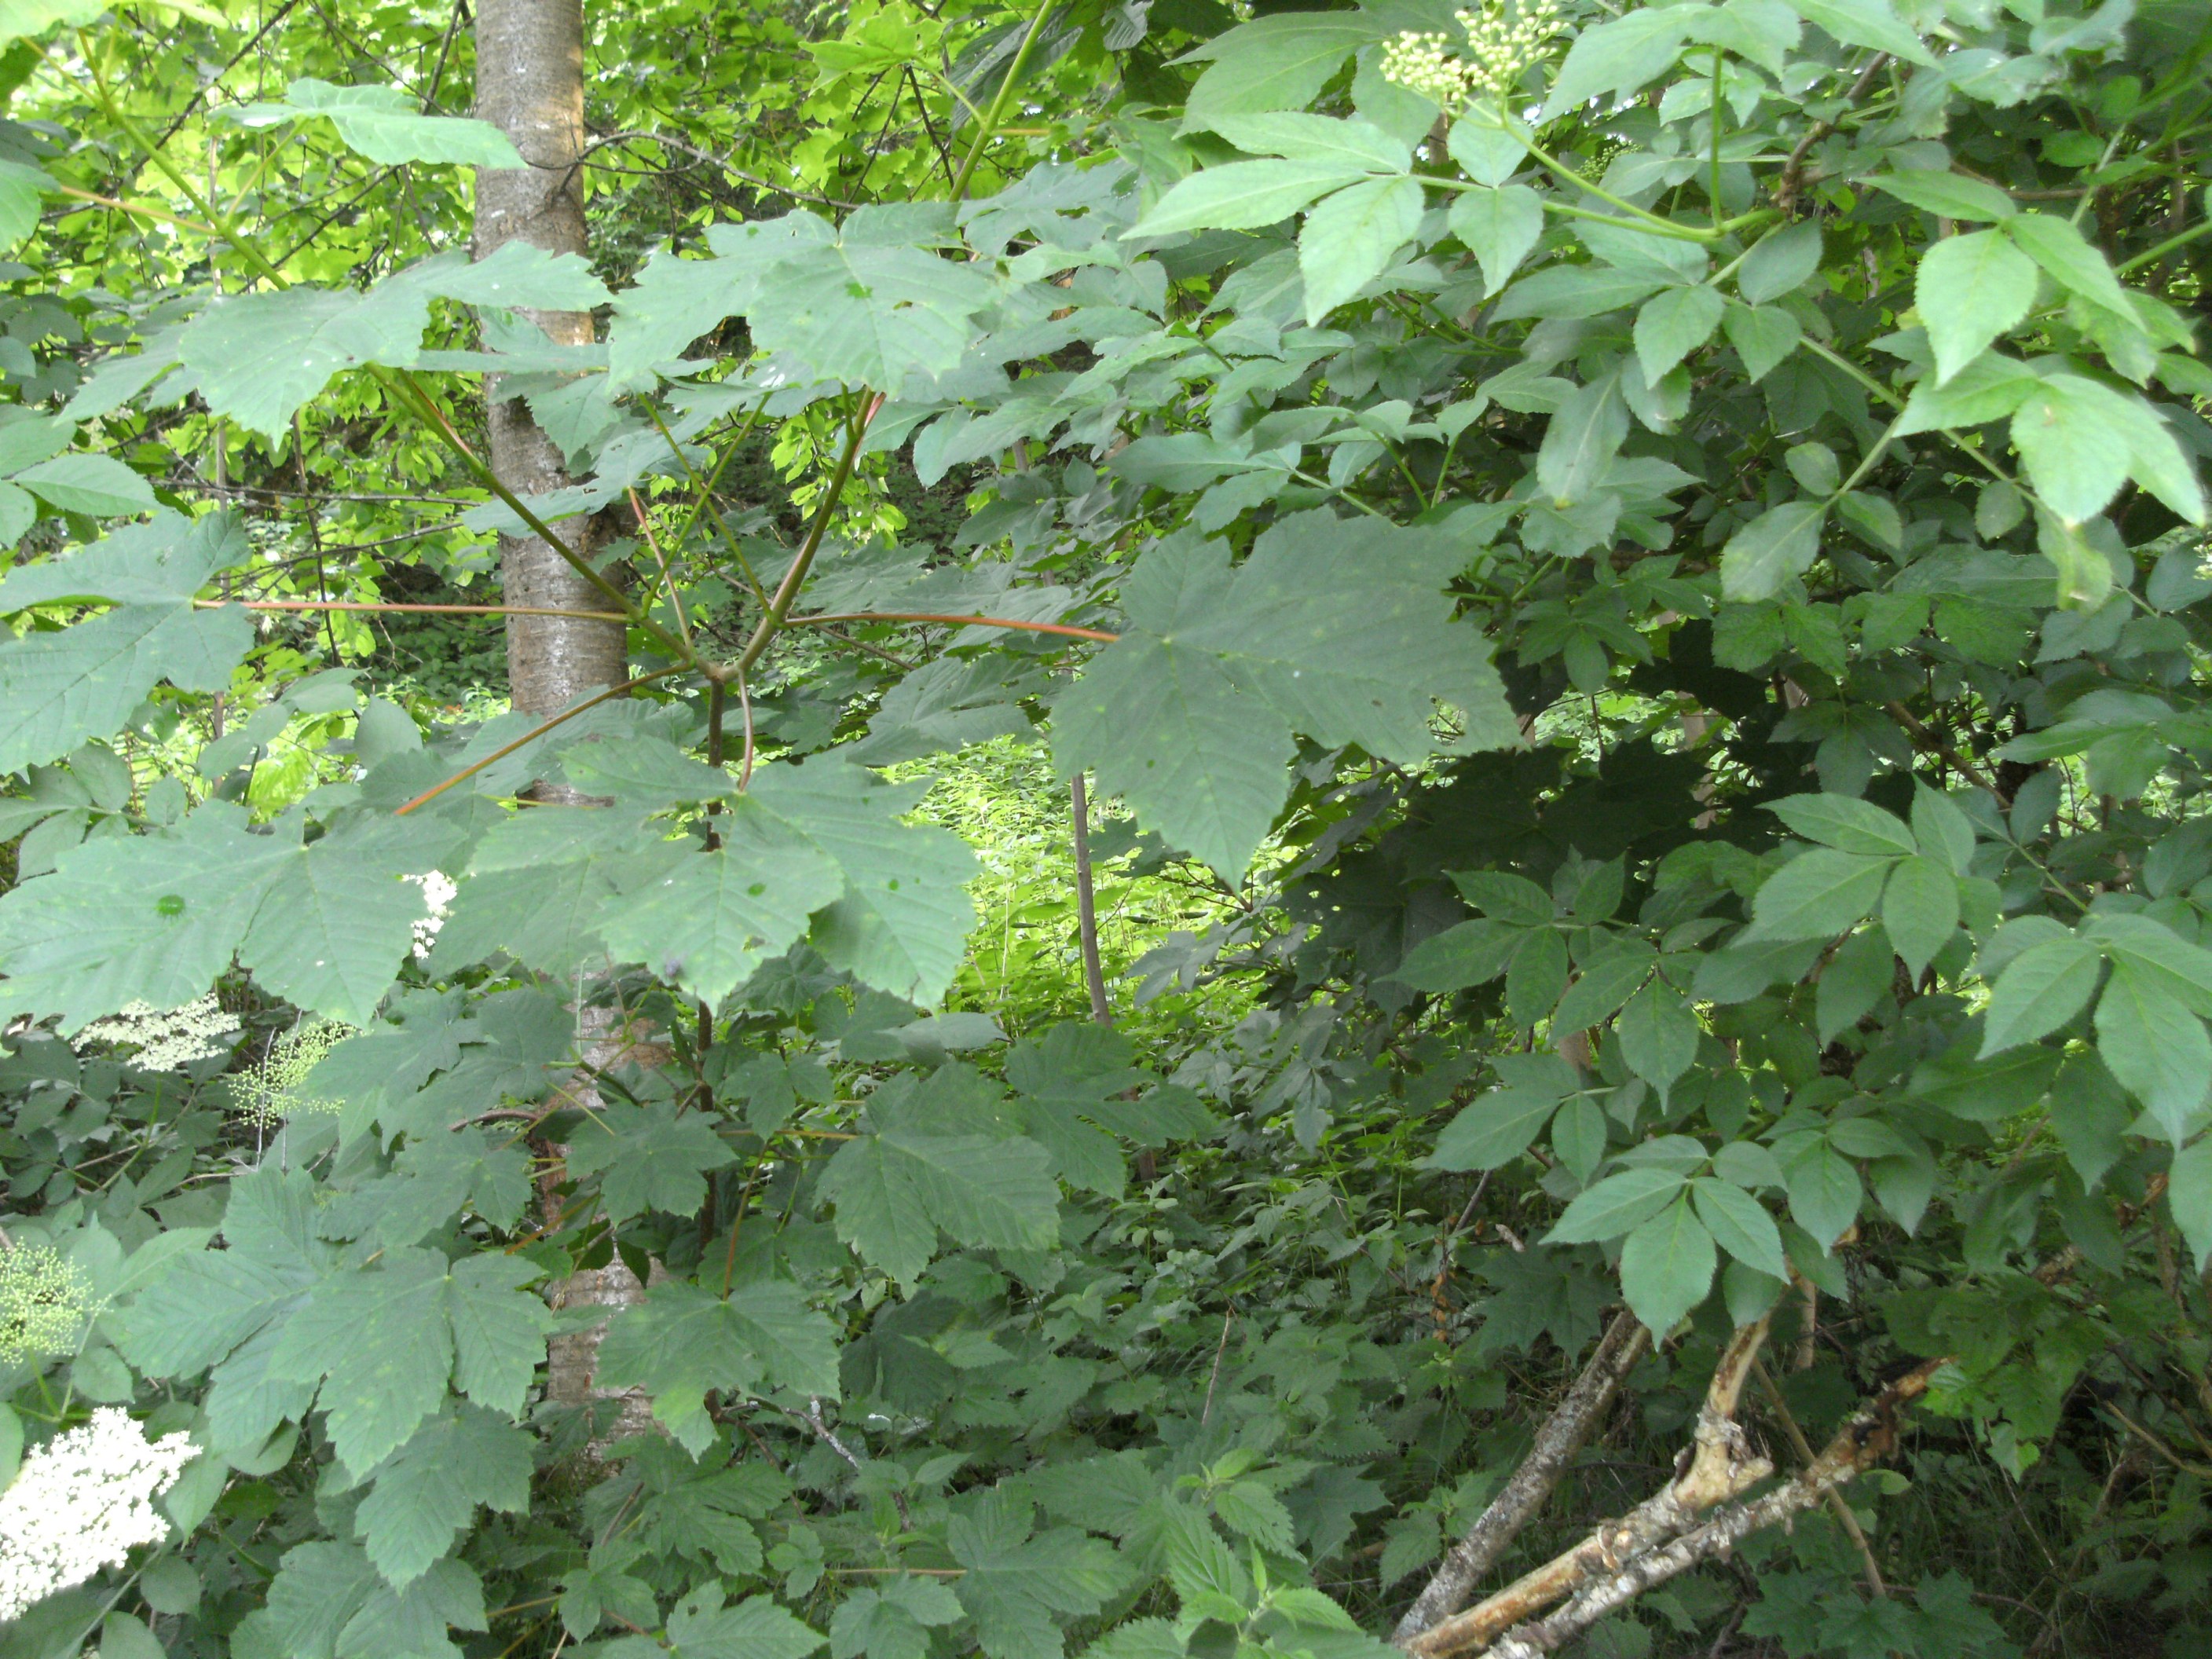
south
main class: Woodland
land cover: Broadleaved woodland
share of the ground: > 75 %
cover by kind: broadleaved forest trees 90 %, shrubs 10 %
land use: Semi-natural and natural areas not in use
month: June
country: AT
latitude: 48.4666
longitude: 14.2335
